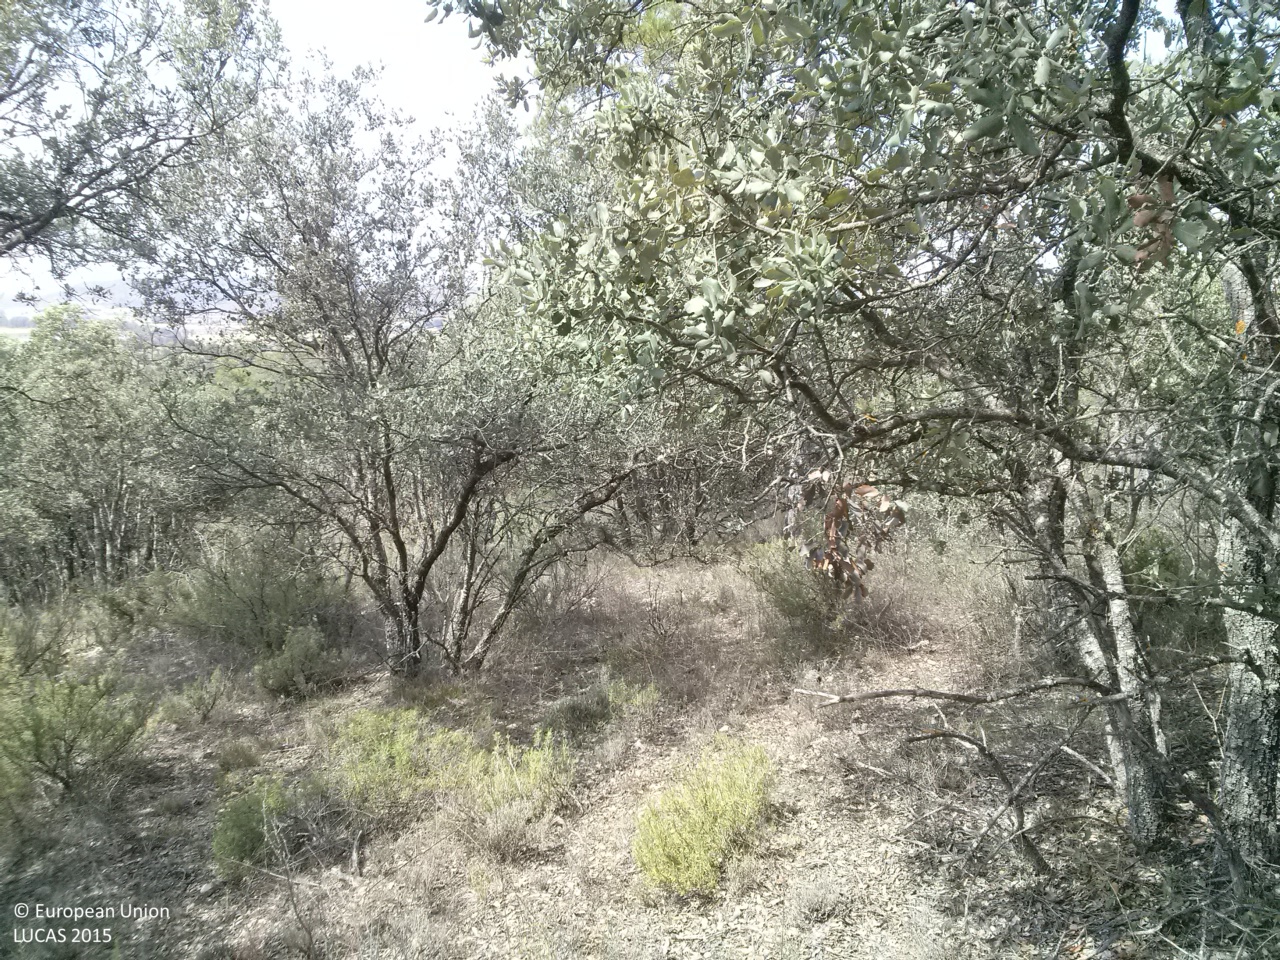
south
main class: Woodland
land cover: Other mixed woodland
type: broadleaved evergreen forest
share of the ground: 50 - 75 %
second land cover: Shrubland without tree cover
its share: 10 - 25 %
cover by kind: broadleaved forest trees 45 %, coniferous forest trees 25 %, shrubs 20 %, herbaceous plants 10 %
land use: Forestry
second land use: Agriculture (excluding fallow land and kitchen gardens)
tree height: > 5 m
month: June
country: ES
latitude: 39.9668
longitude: -1.8485
